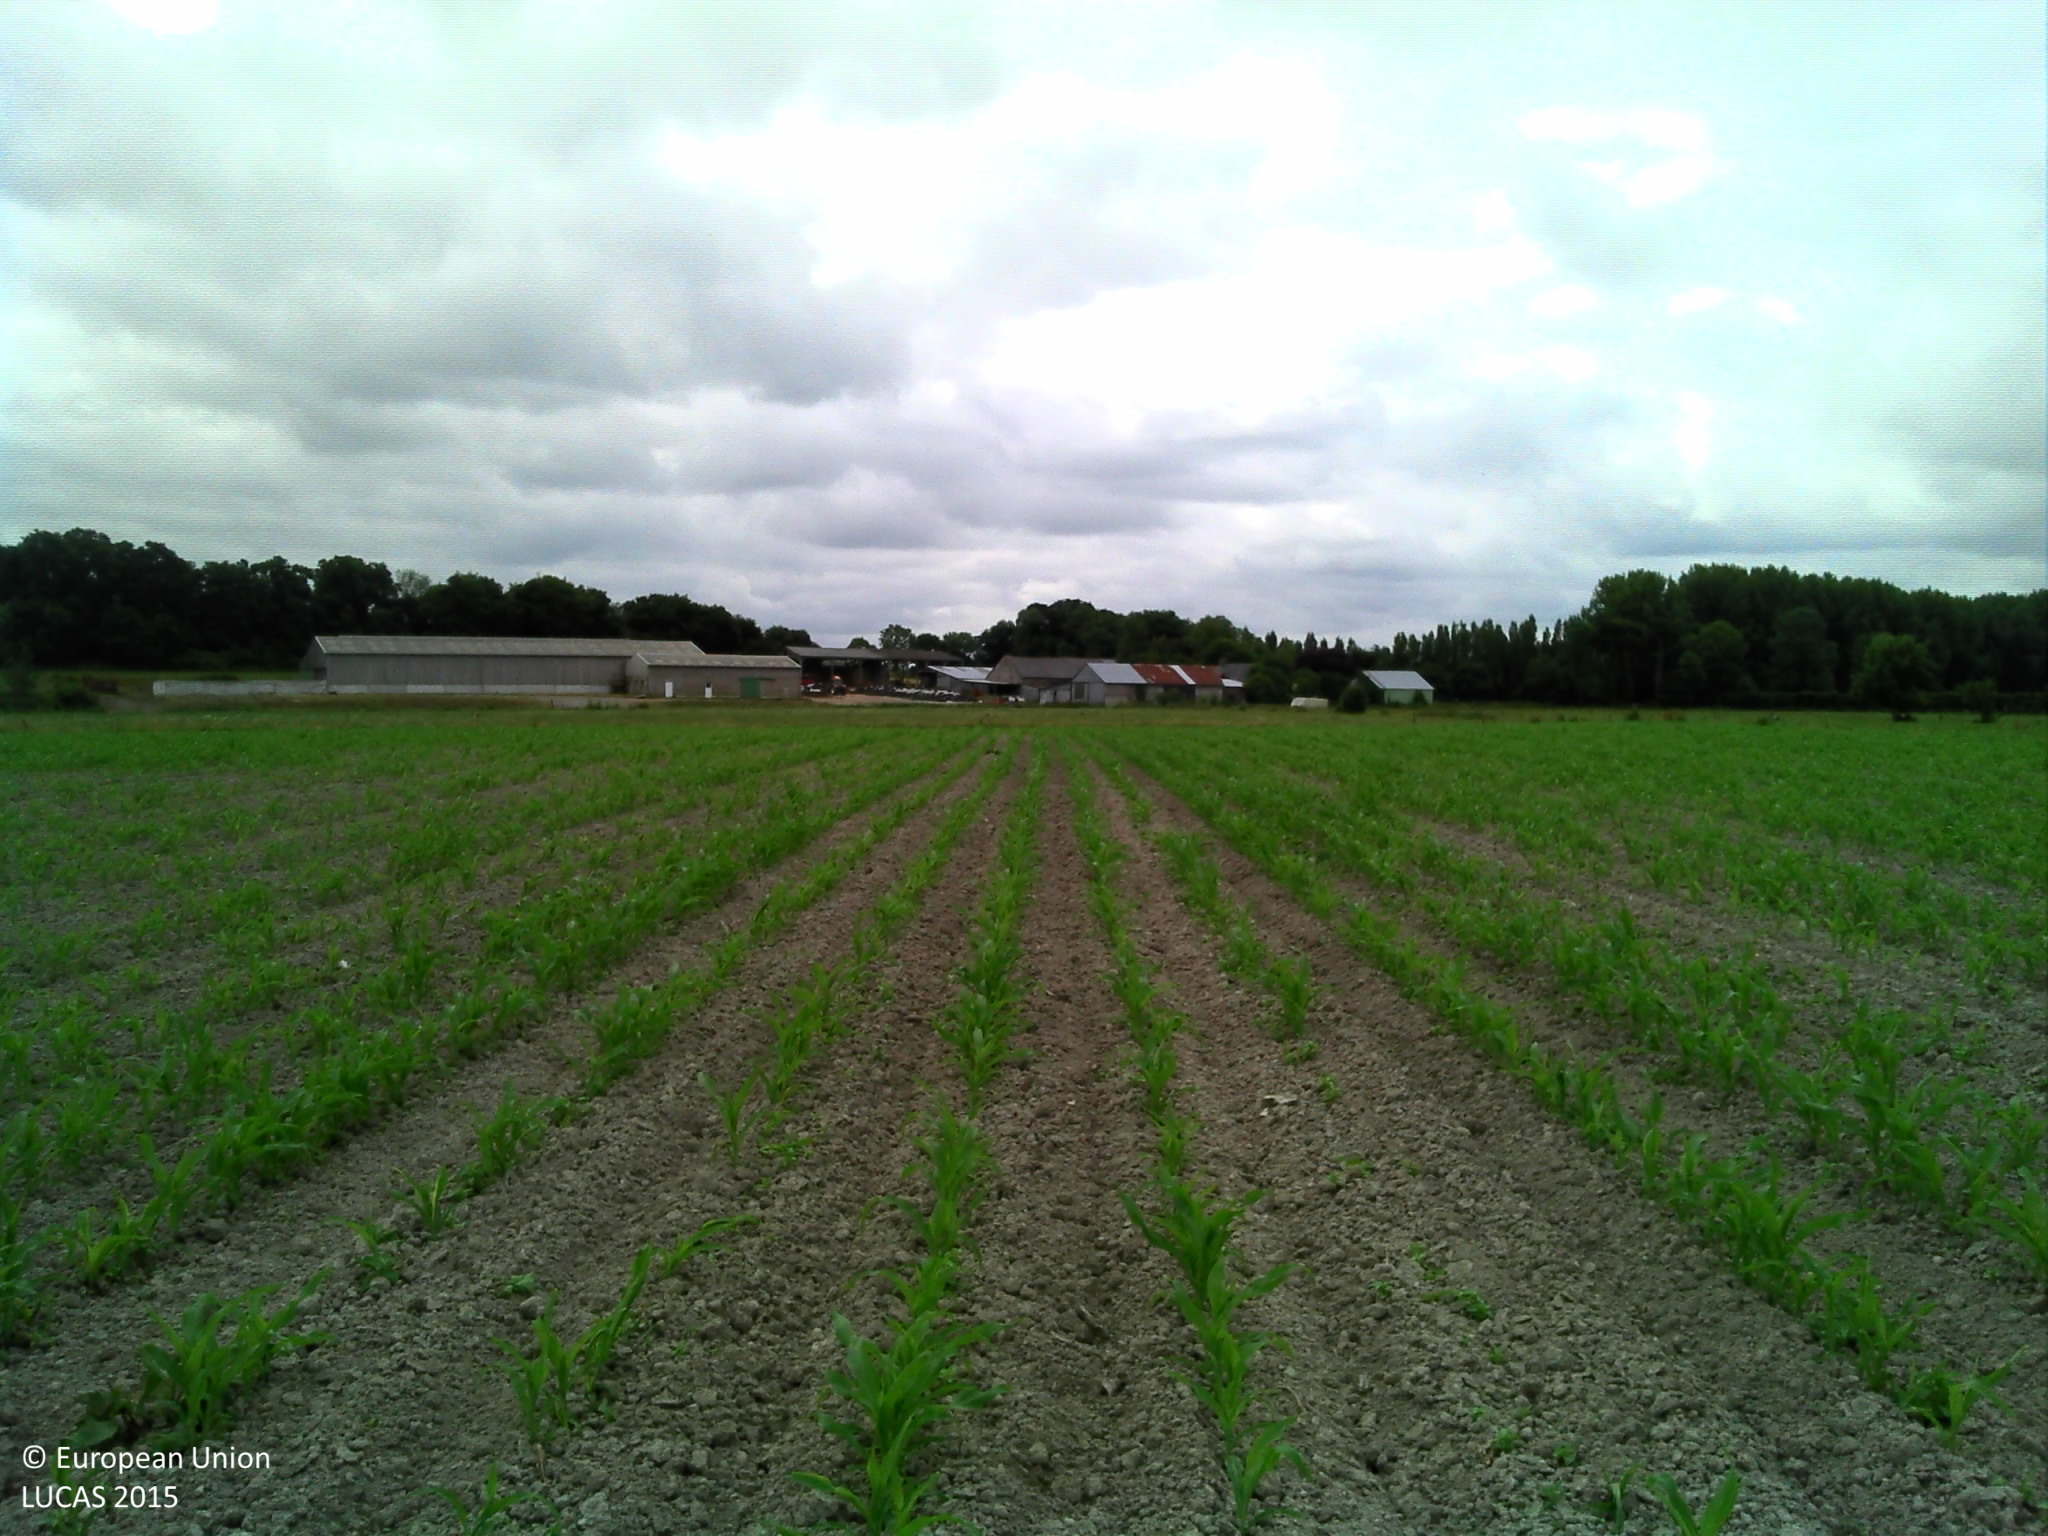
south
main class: Cropland
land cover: Maize
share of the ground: 10 - 25 %
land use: Agriculture (excluding fallow land and kitchen gardens)
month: June
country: FR
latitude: 48.5633
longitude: -1.8547
